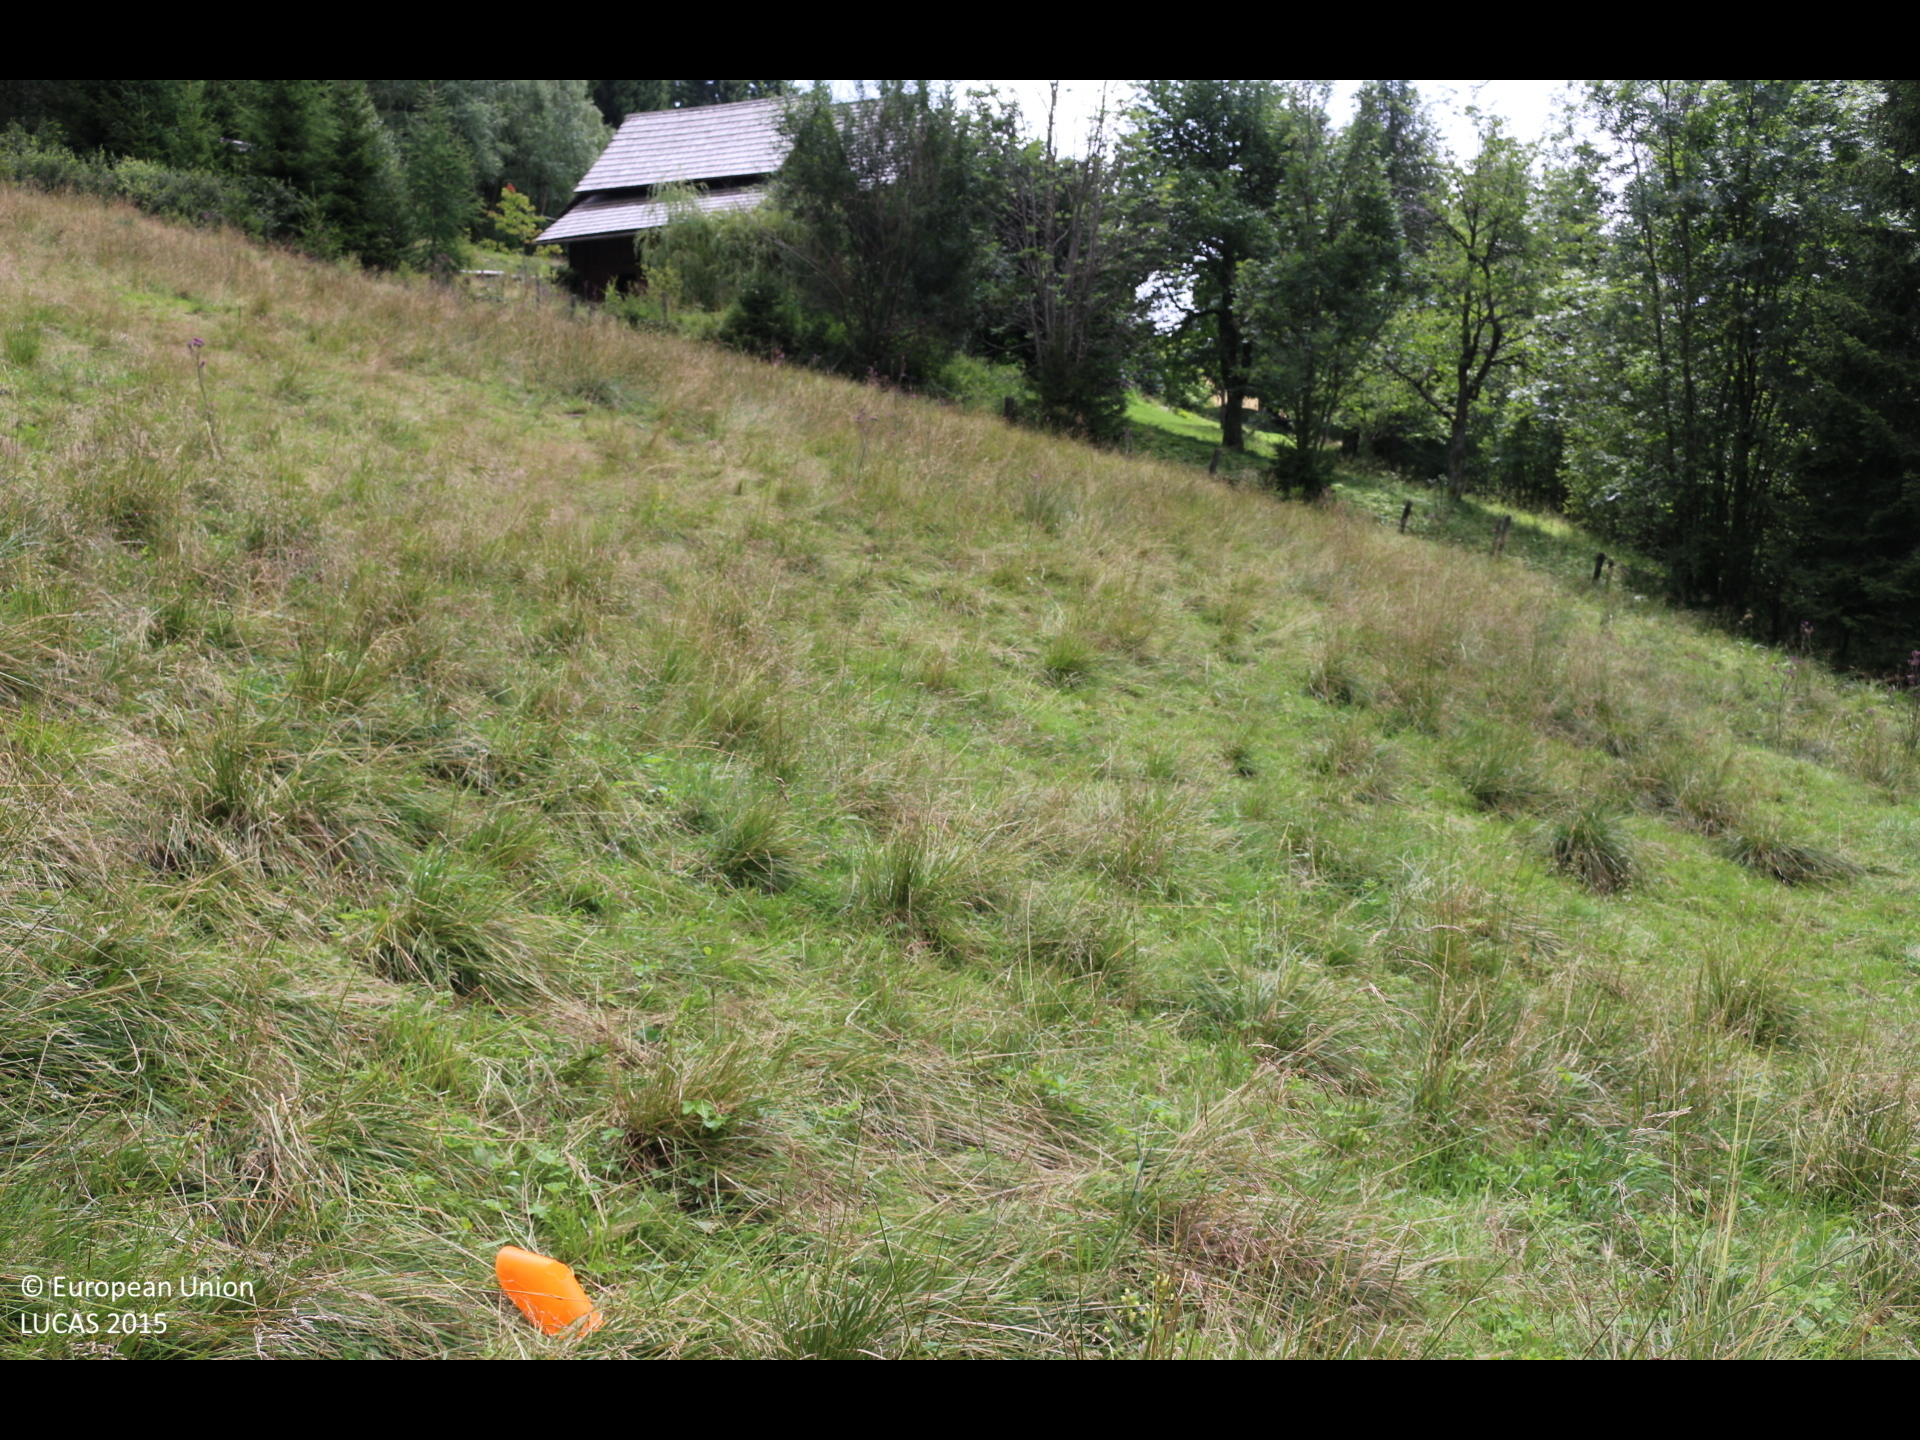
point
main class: Grassland
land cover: Grassland without tree/shrub cover
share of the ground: > 75 %
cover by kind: herbaceous plants 100 %
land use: Agriculture (excluding fallow land and kitchen gardens)
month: July
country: AT
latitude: 46.7475
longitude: 13.9375
